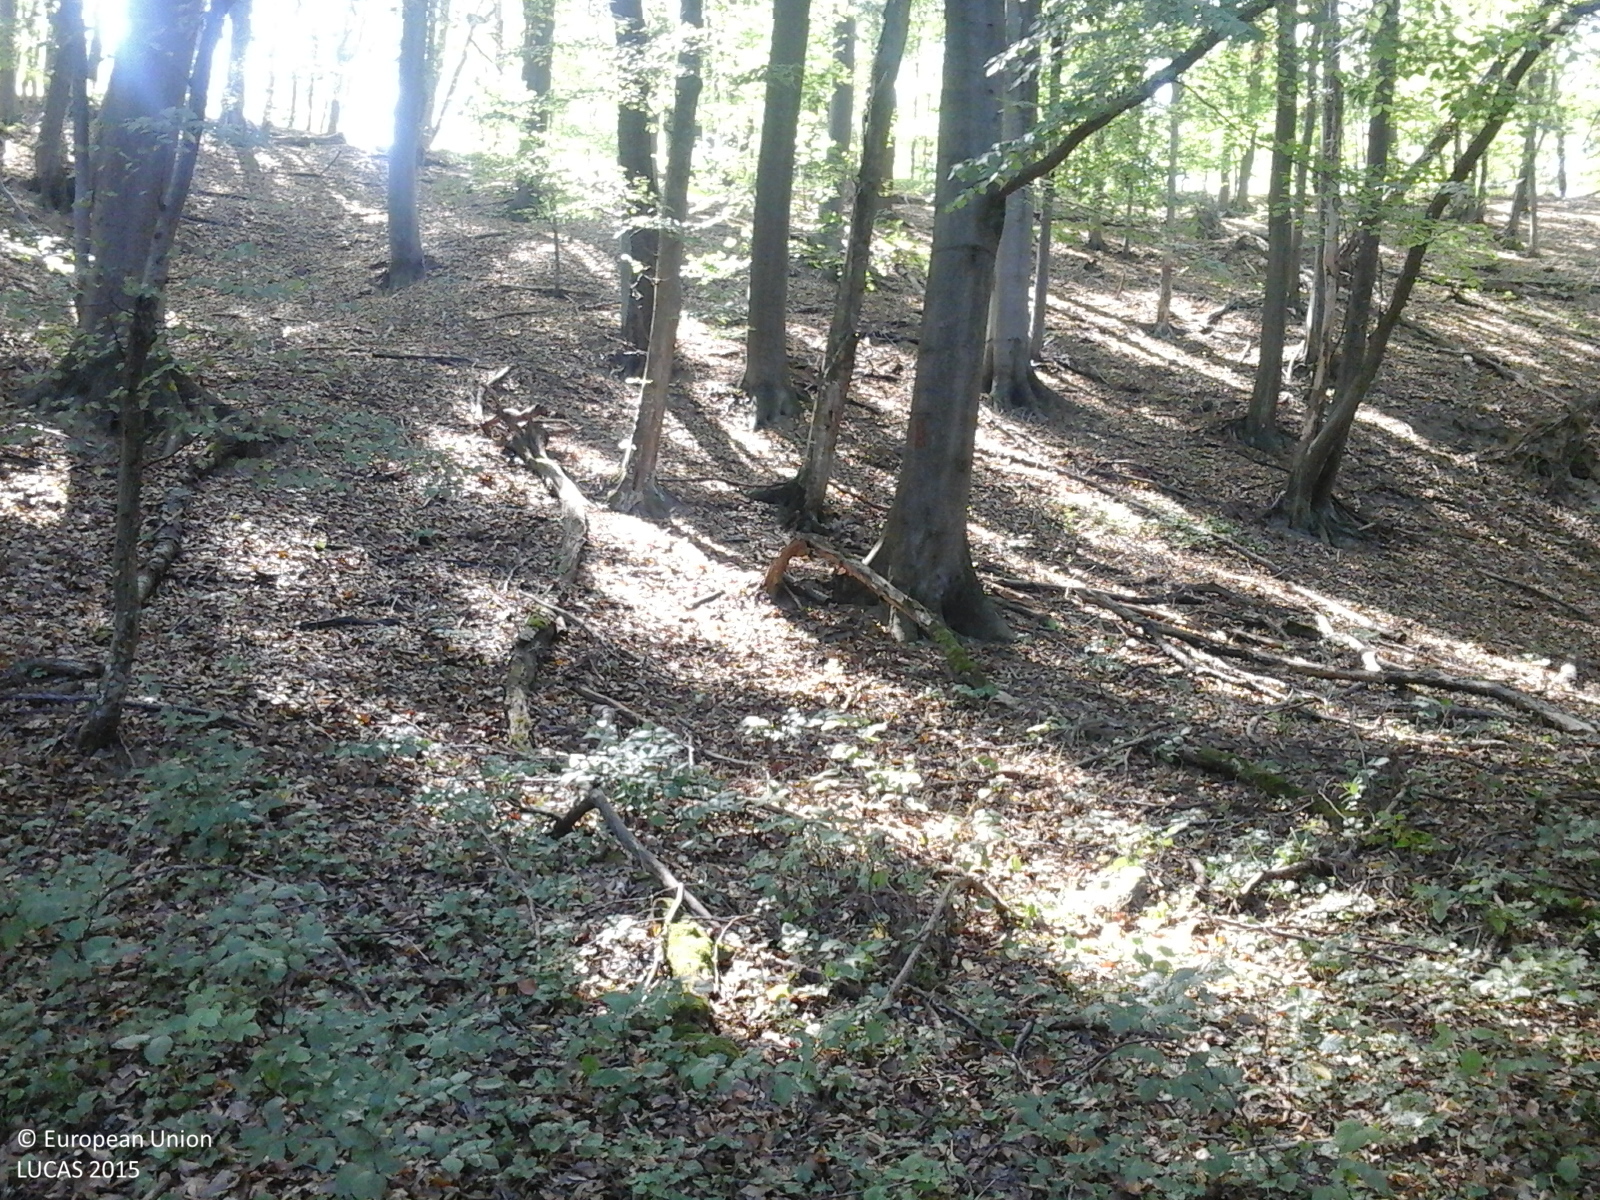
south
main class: Woodland
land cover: Broadleaved woodland
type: beech forest
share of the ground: > 75 %
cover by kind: broadleaved forest trees 100 %
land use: Forestry
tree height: > 5 m
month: August
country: RO
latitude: 45.9010
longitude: 22.6954
